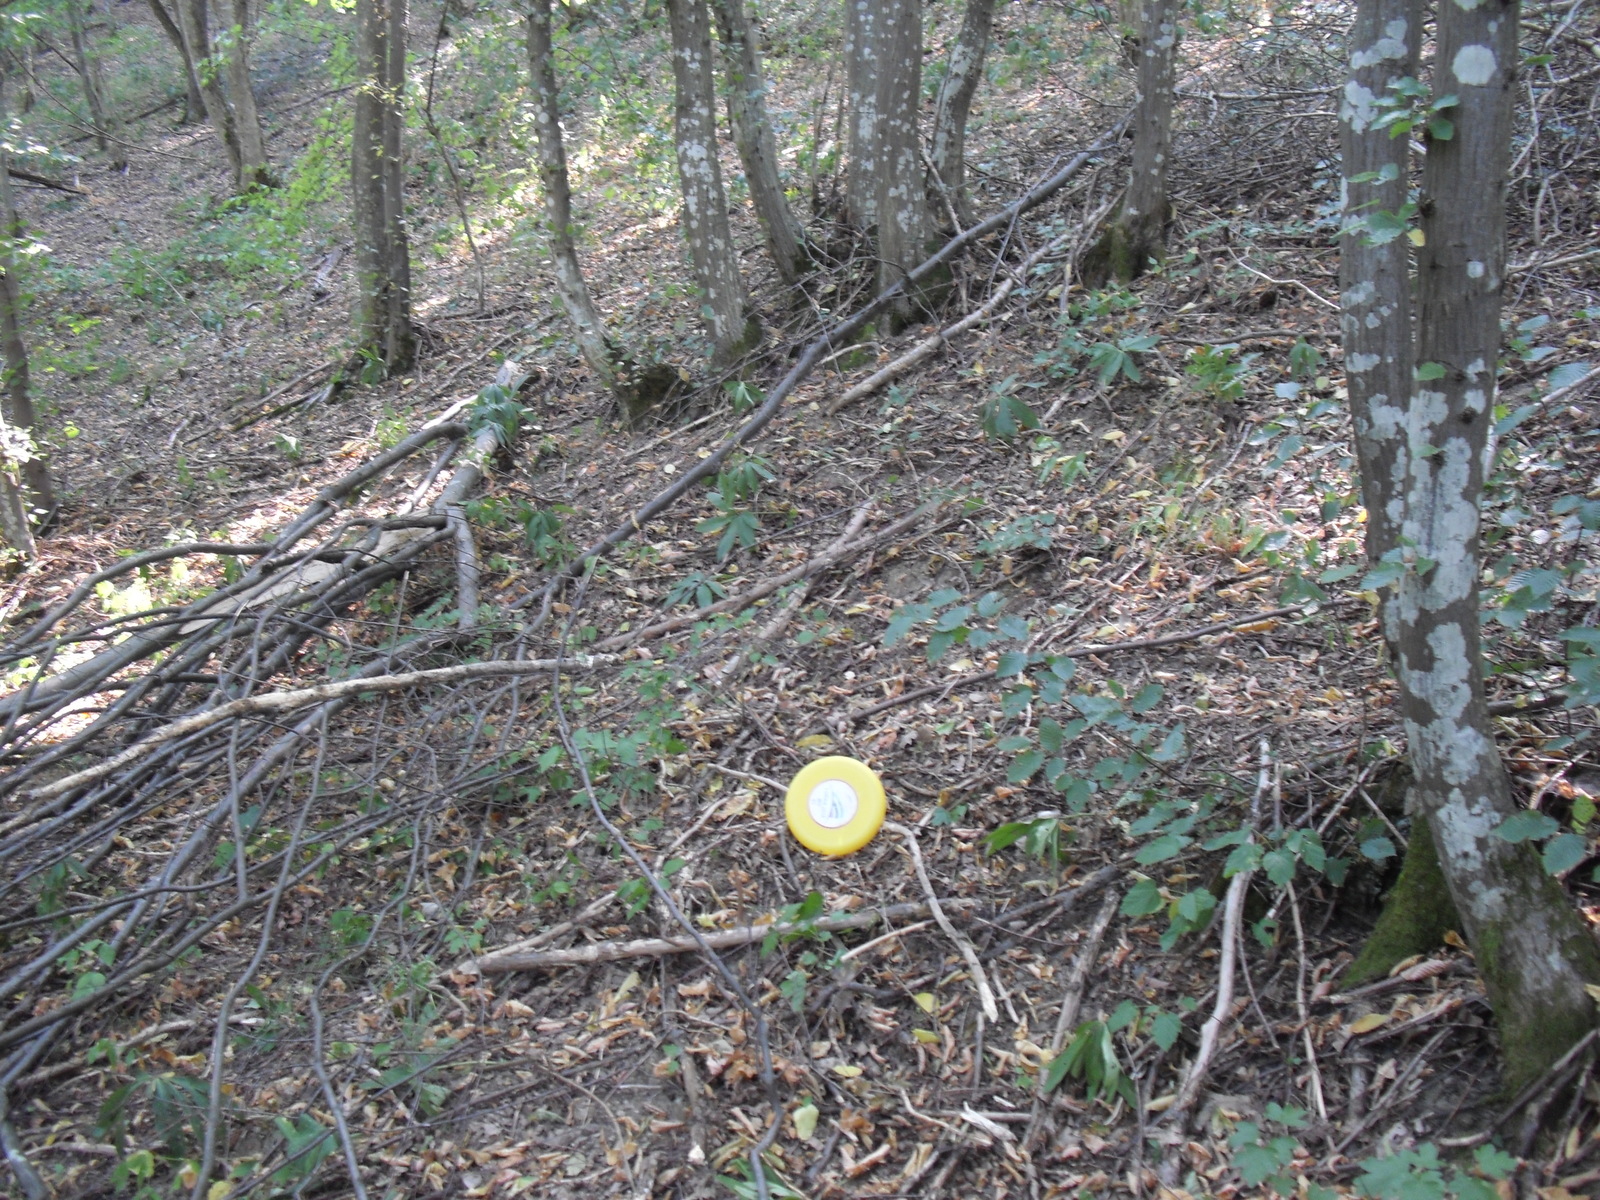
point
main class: Woodland
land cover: Broadleaved woodland
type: beech forest
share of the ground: > 75 %
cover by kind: broadleaved forest trees 95 %, shrubs 5 %
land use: Forestry
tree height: > 5 m
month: August
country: BG
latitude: 43.2679
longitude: 23.1836
